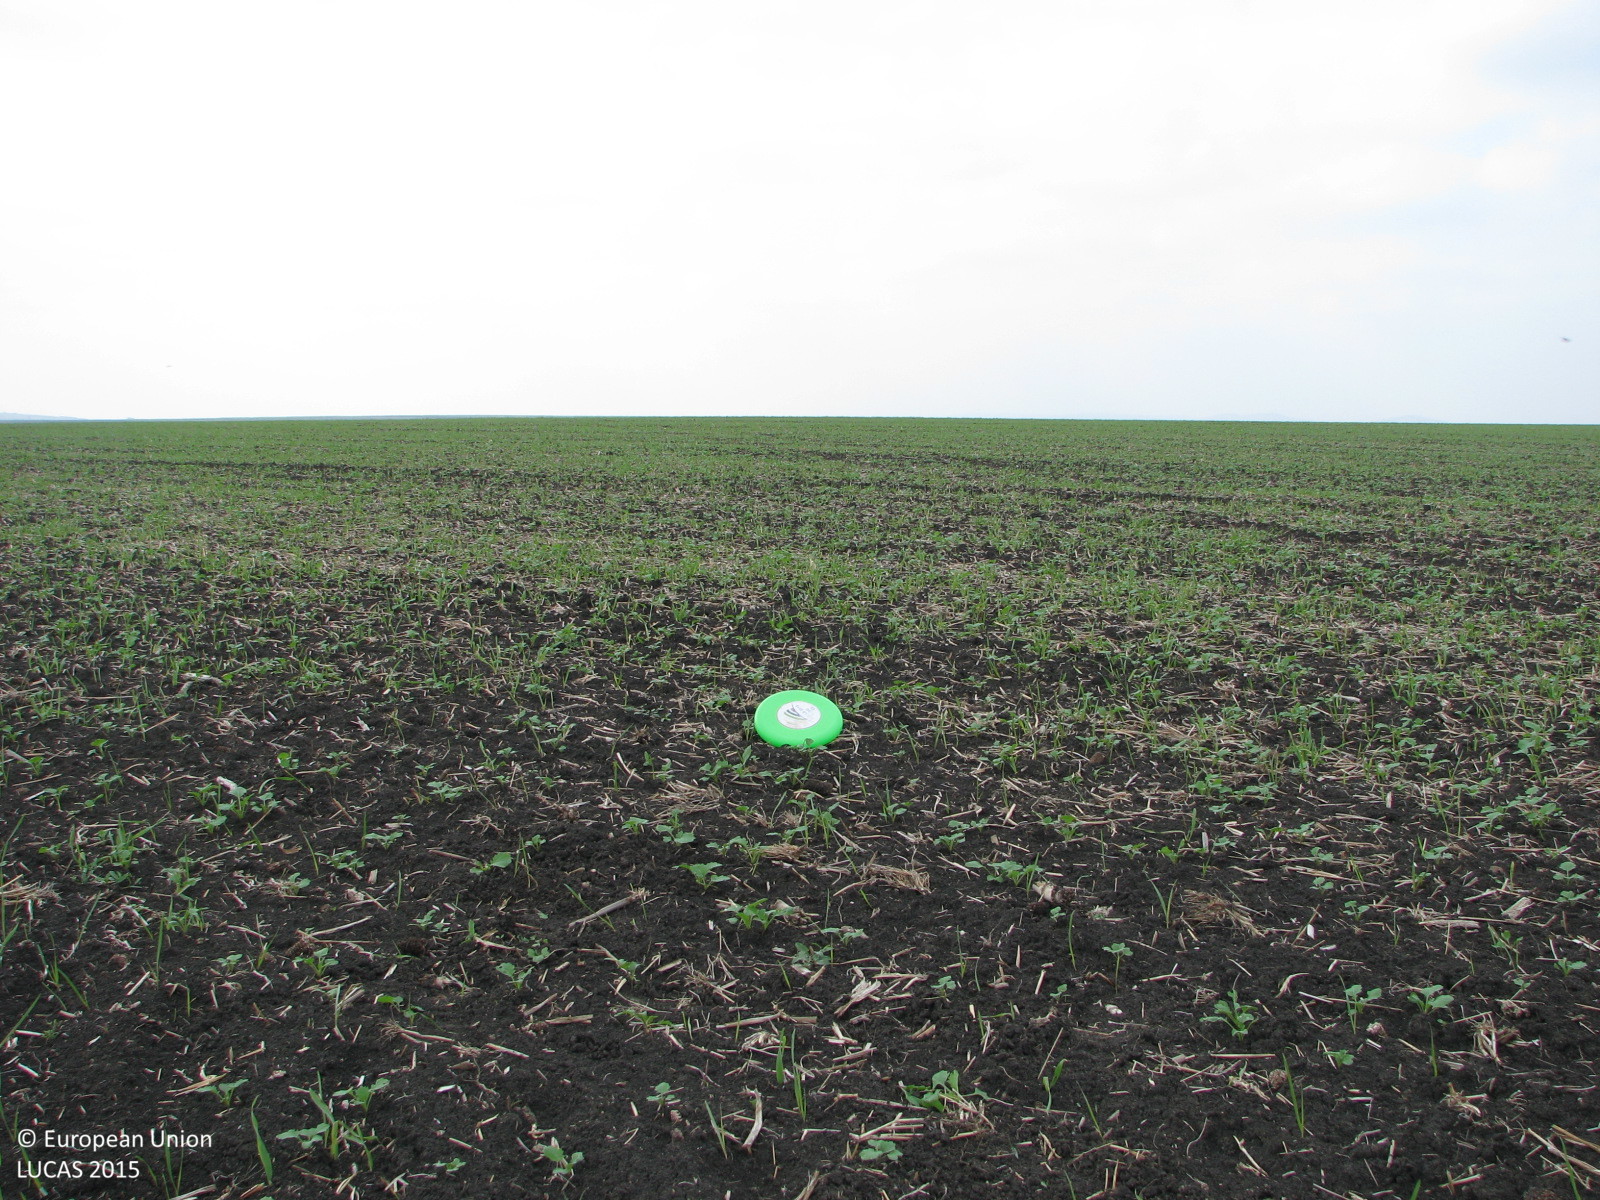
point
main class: Cropland
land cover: Rape and turnip rape
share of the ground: 10 - 25 %
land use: Agriculture (excluding fallow land and kitchen gardens)
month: October
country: BG
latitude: 42.3012
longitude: 26.5019
